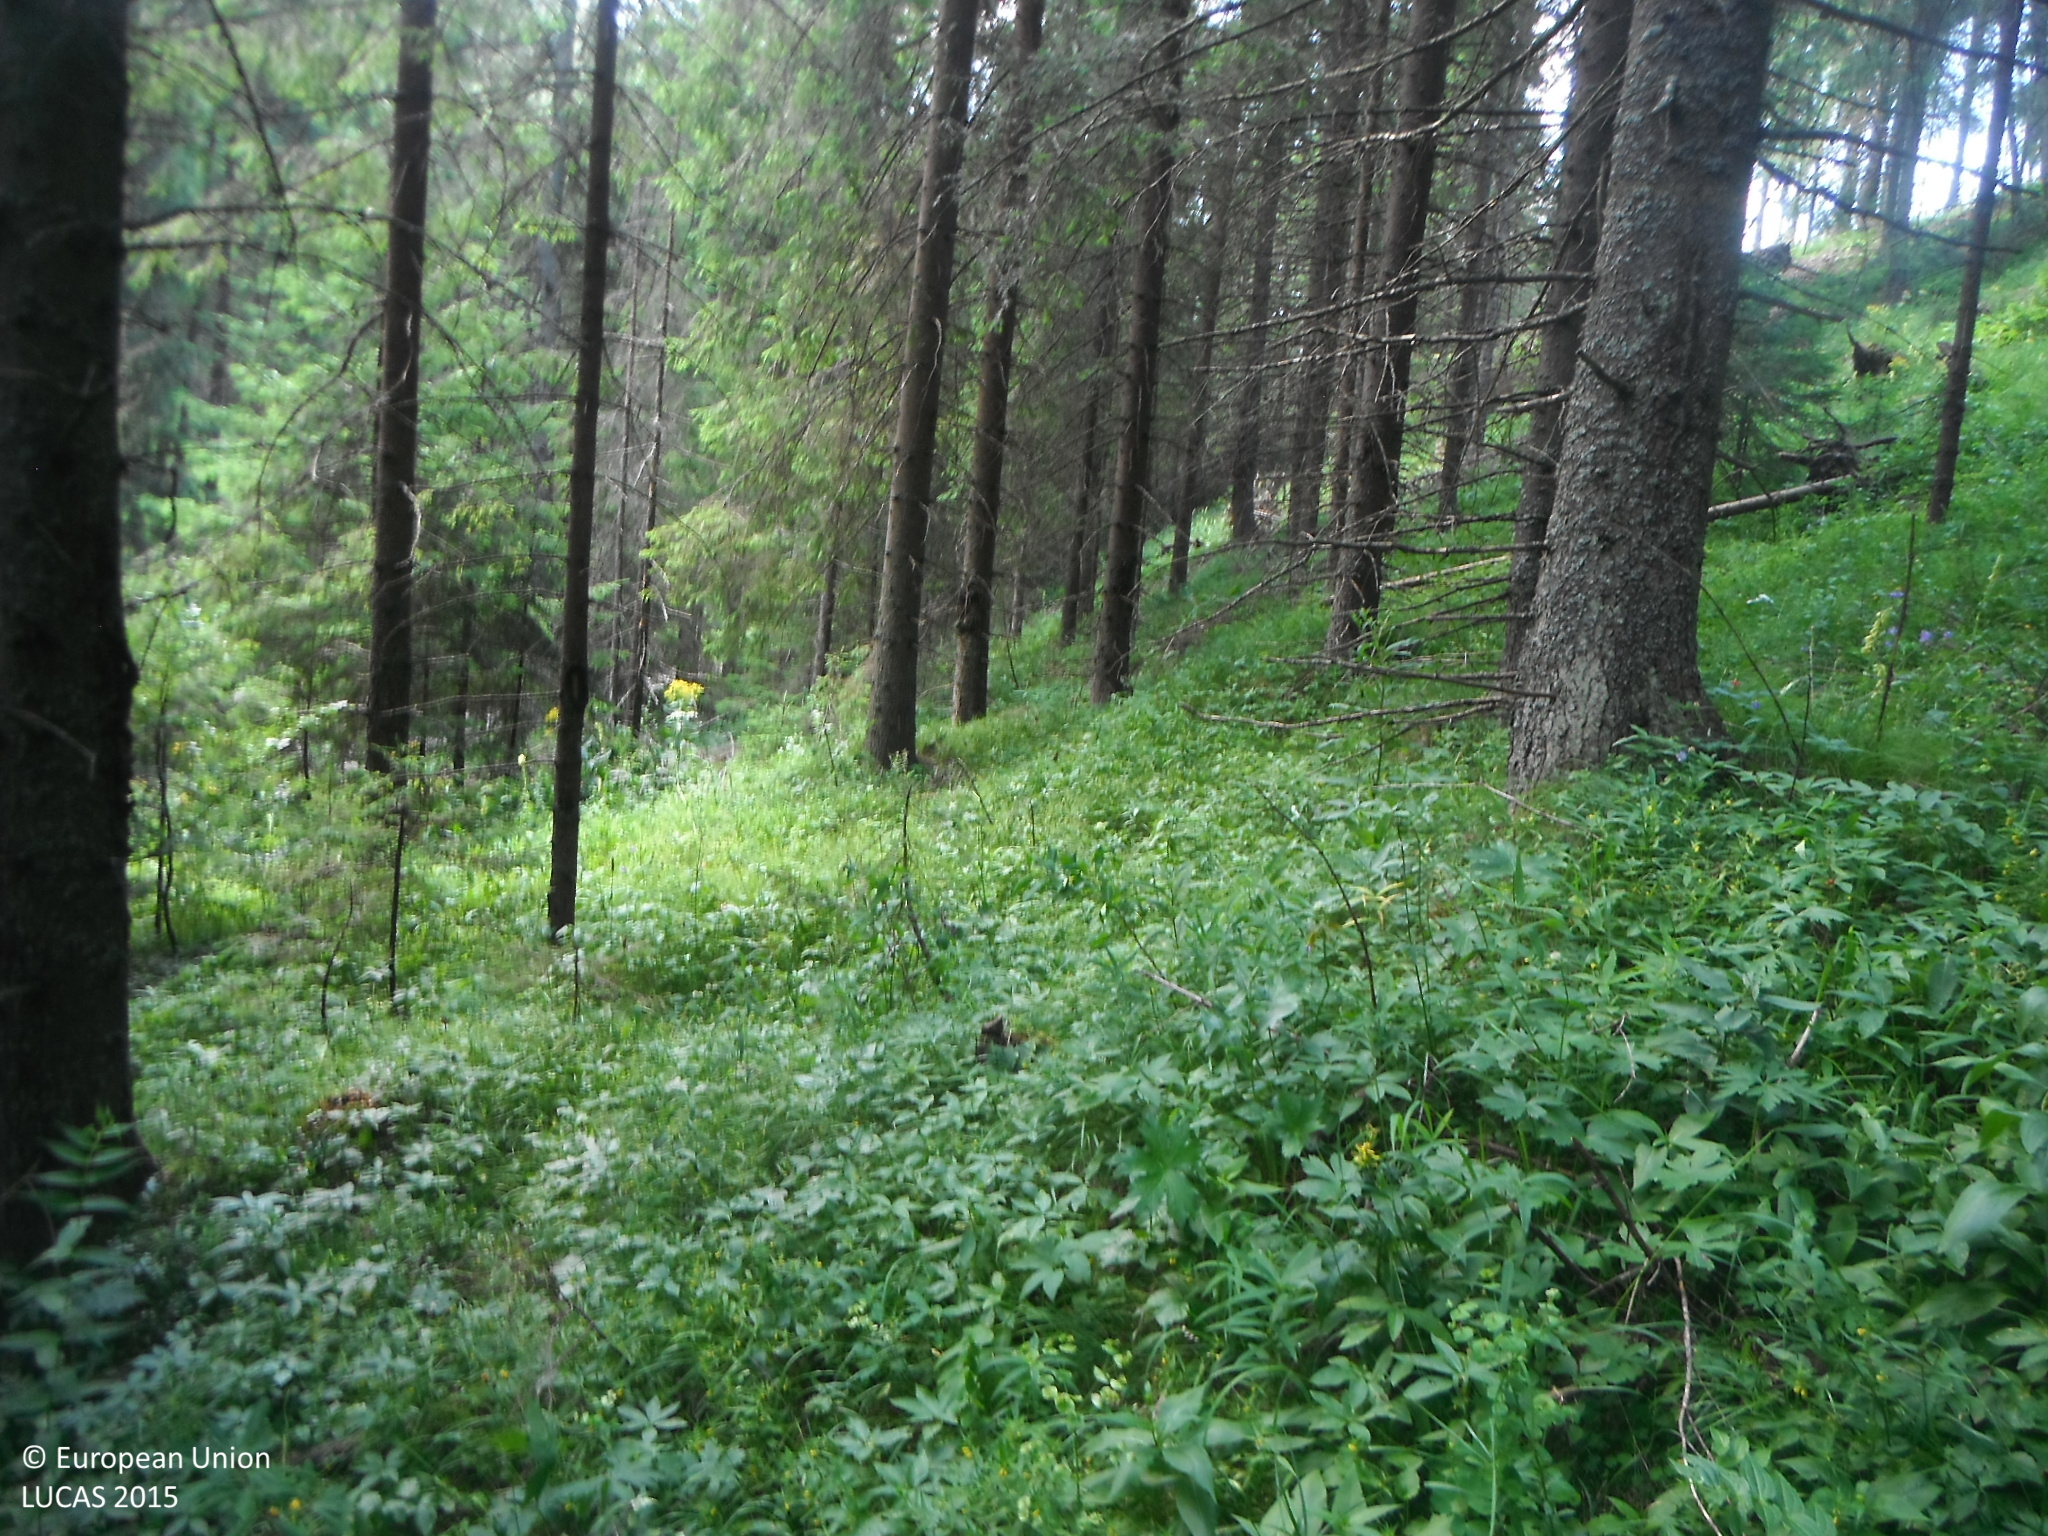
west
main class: Woodland
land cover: Spruce dominated coniferous woodland
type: alpine coniferous forest
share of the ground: > 75 %
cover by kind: coniferous forest trees 100 %
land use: Forestry
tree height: > 5 m
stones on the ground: > 50 %
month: July
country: SK
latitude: 49.2861
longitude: 20.2486
